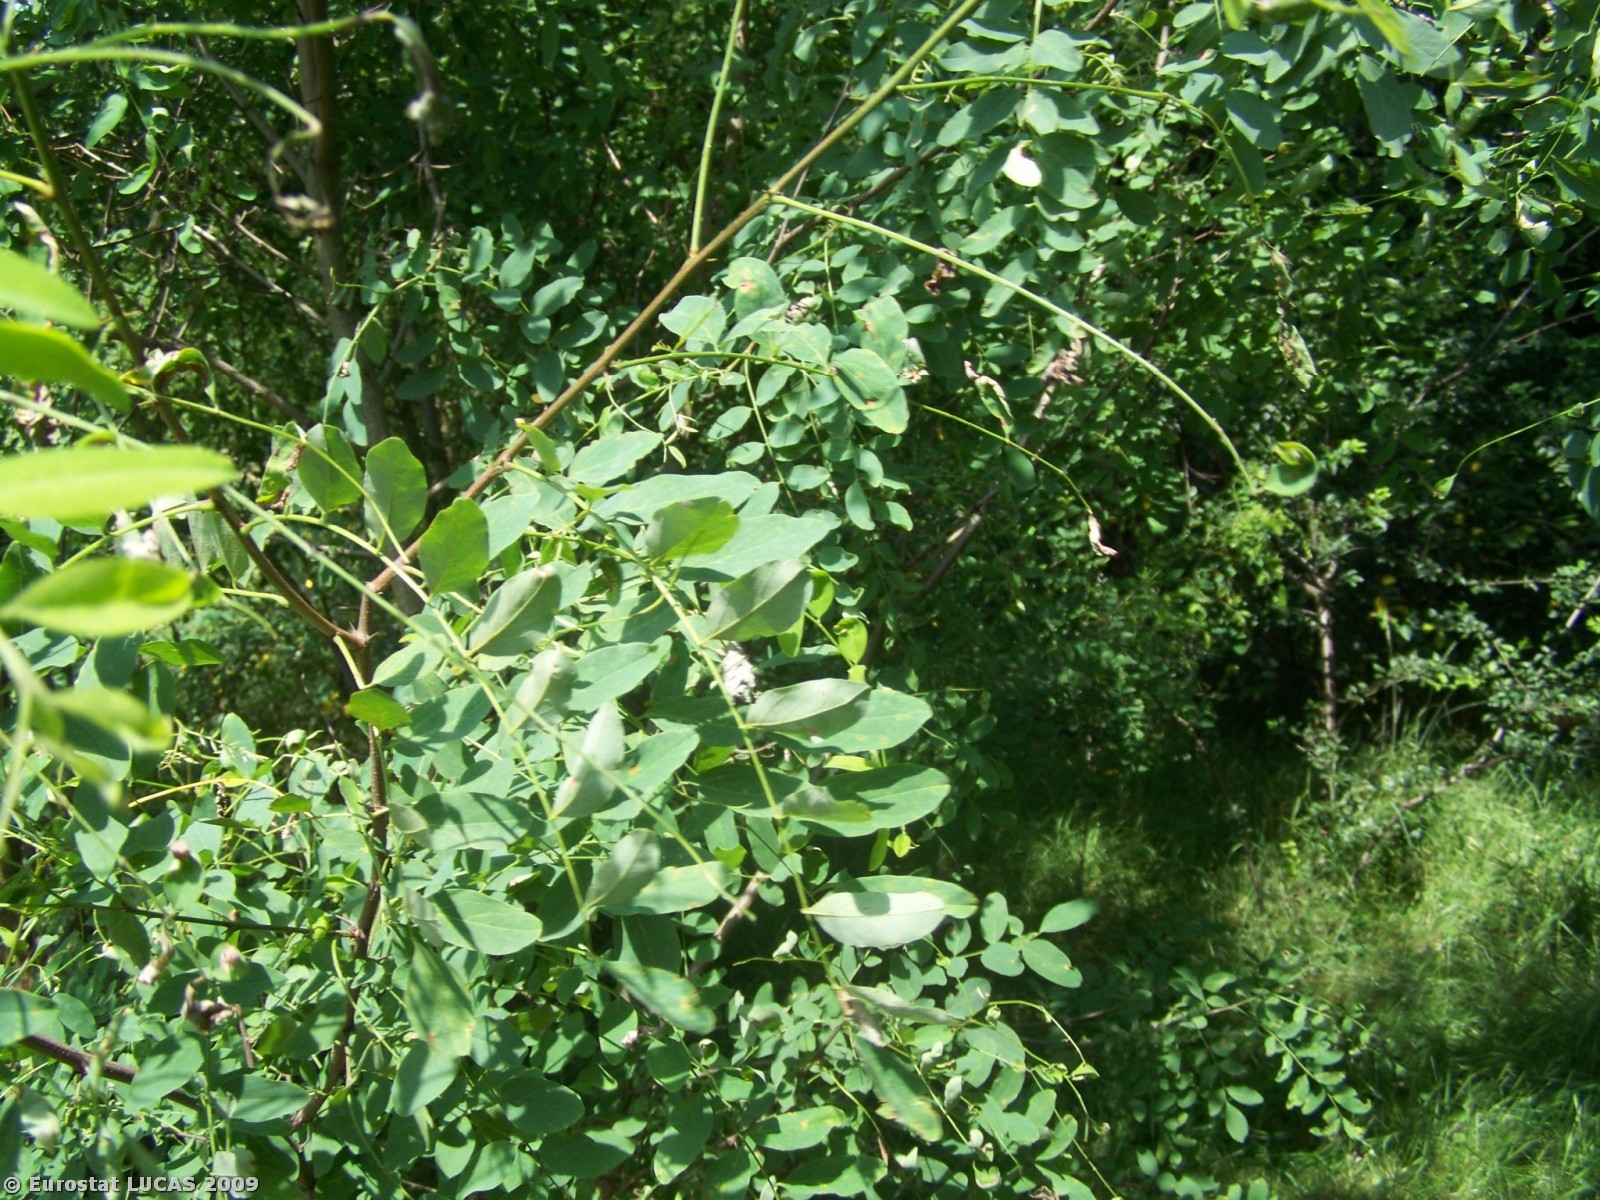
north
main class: Grassland
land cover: Grassland with sparse tree/shrub cover
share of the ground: > 75 %
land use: Unused
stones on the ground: < 10 %
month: July
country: PL
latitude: 52.0419
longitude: 22.1471
